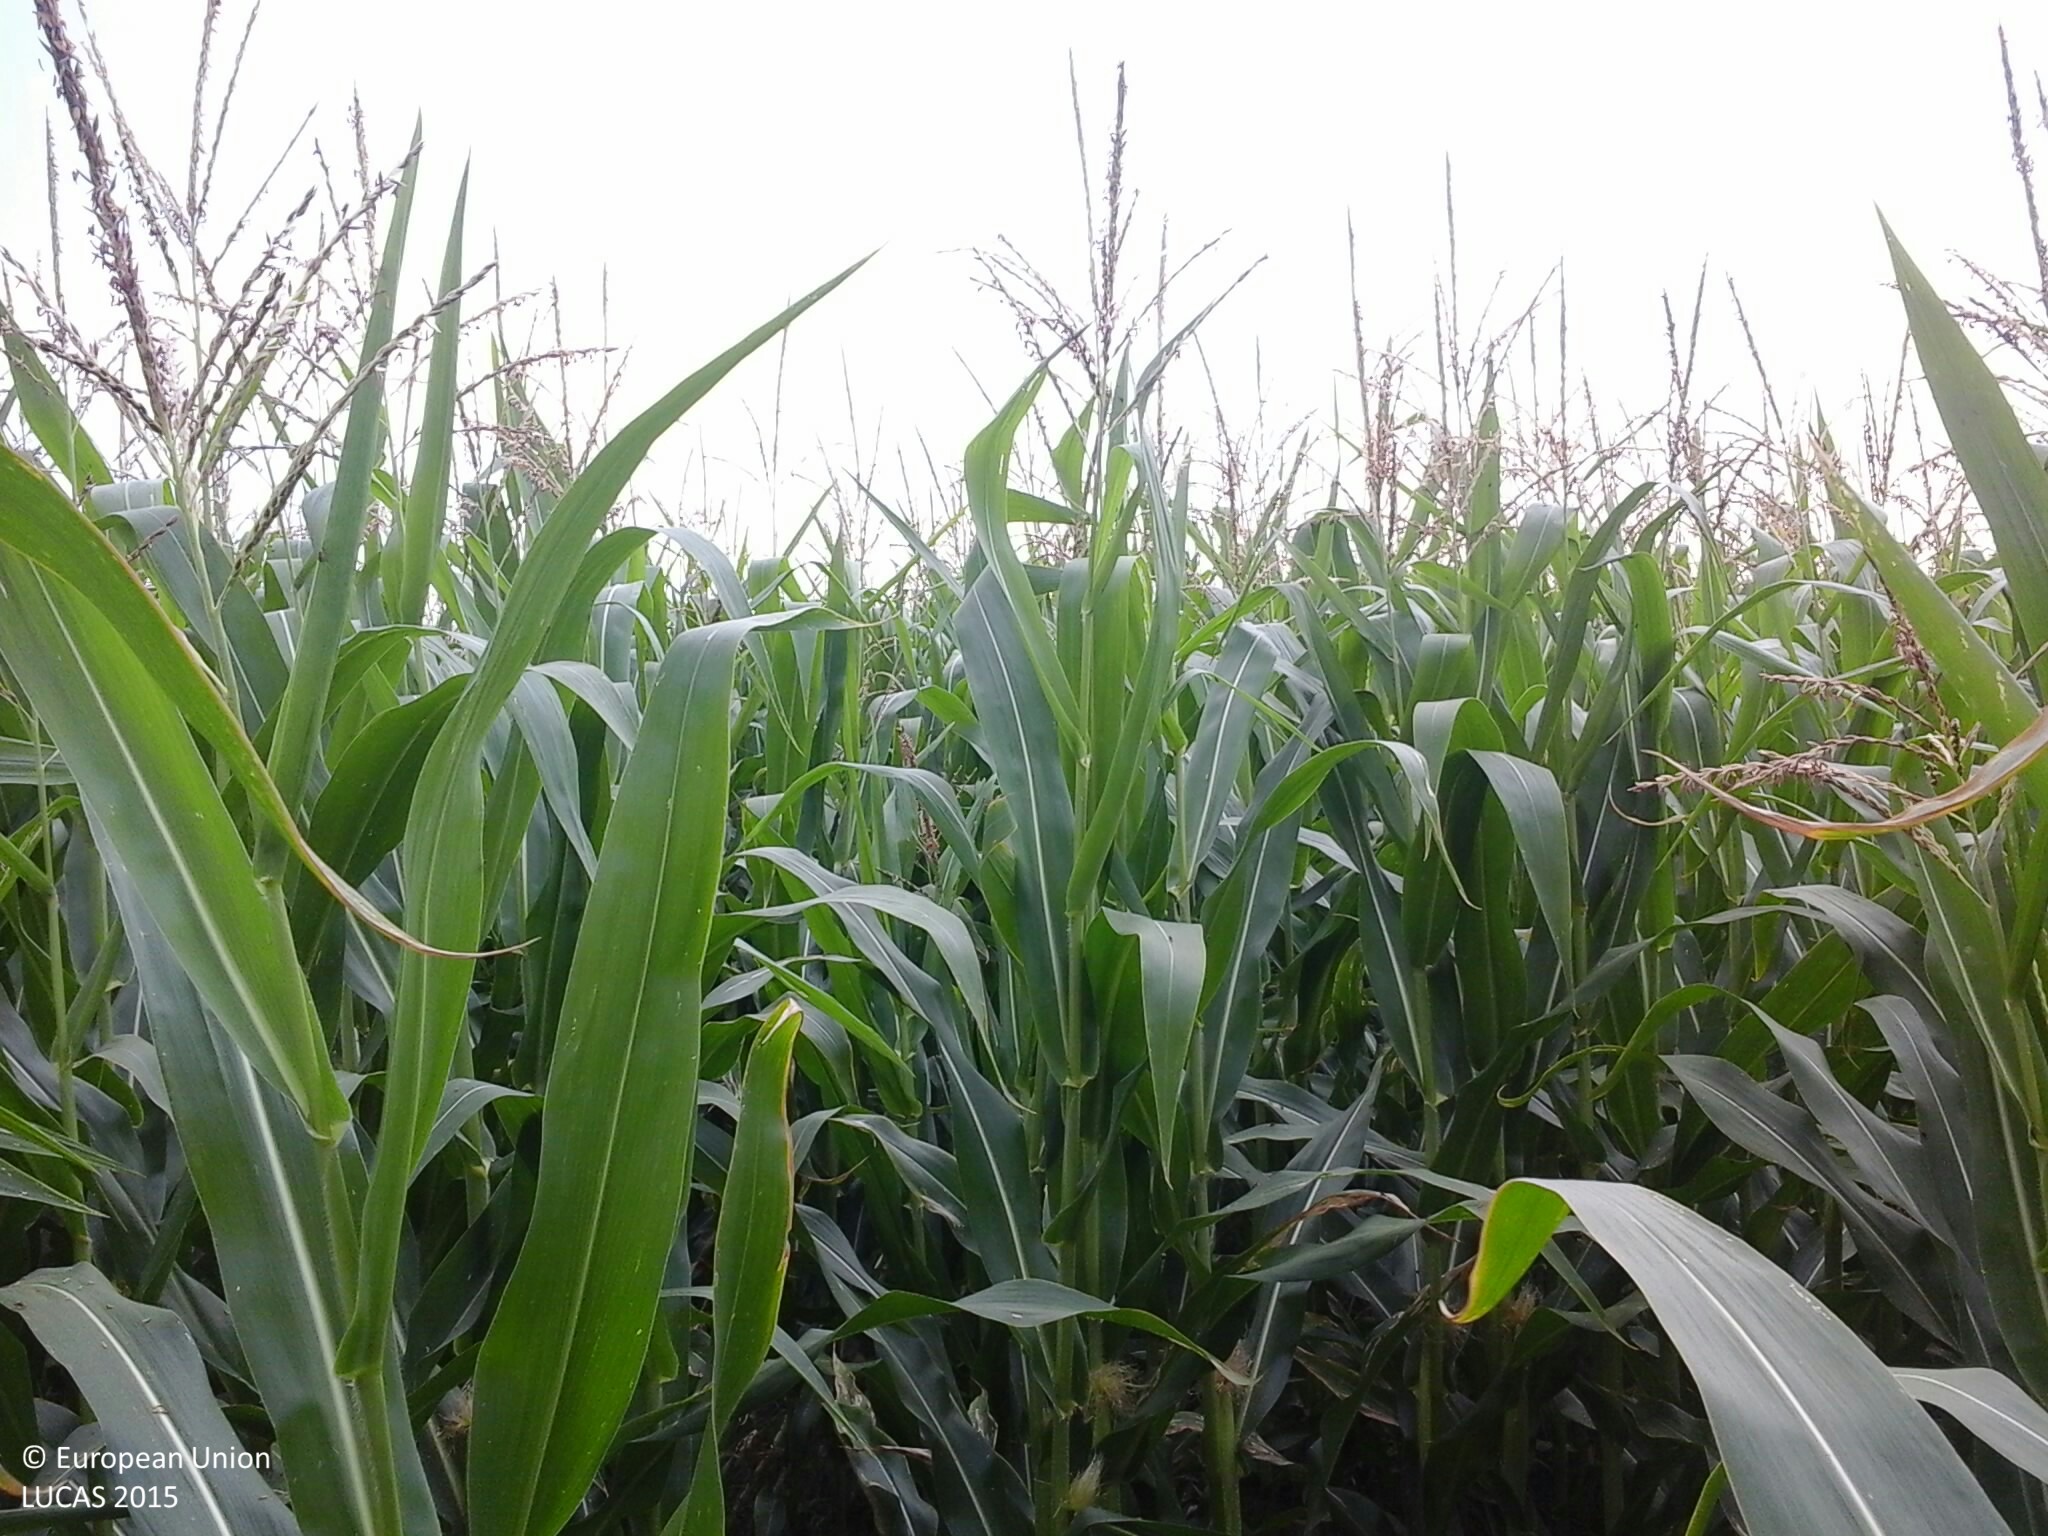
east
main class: Cropland
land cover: Maize
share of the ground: > 75 %
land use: Agriculture (excluding fallow land and kitchen gardens)
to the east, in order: Maize; Lucerne; Sunflower; Maize; Shrubland without tree cover; Ditches and canals; Shrubland without tree cover; Spontaneously vegetated surfaces; Broadleaved woodland
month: July
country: HU
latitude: 47.9141
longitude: 22.1362
